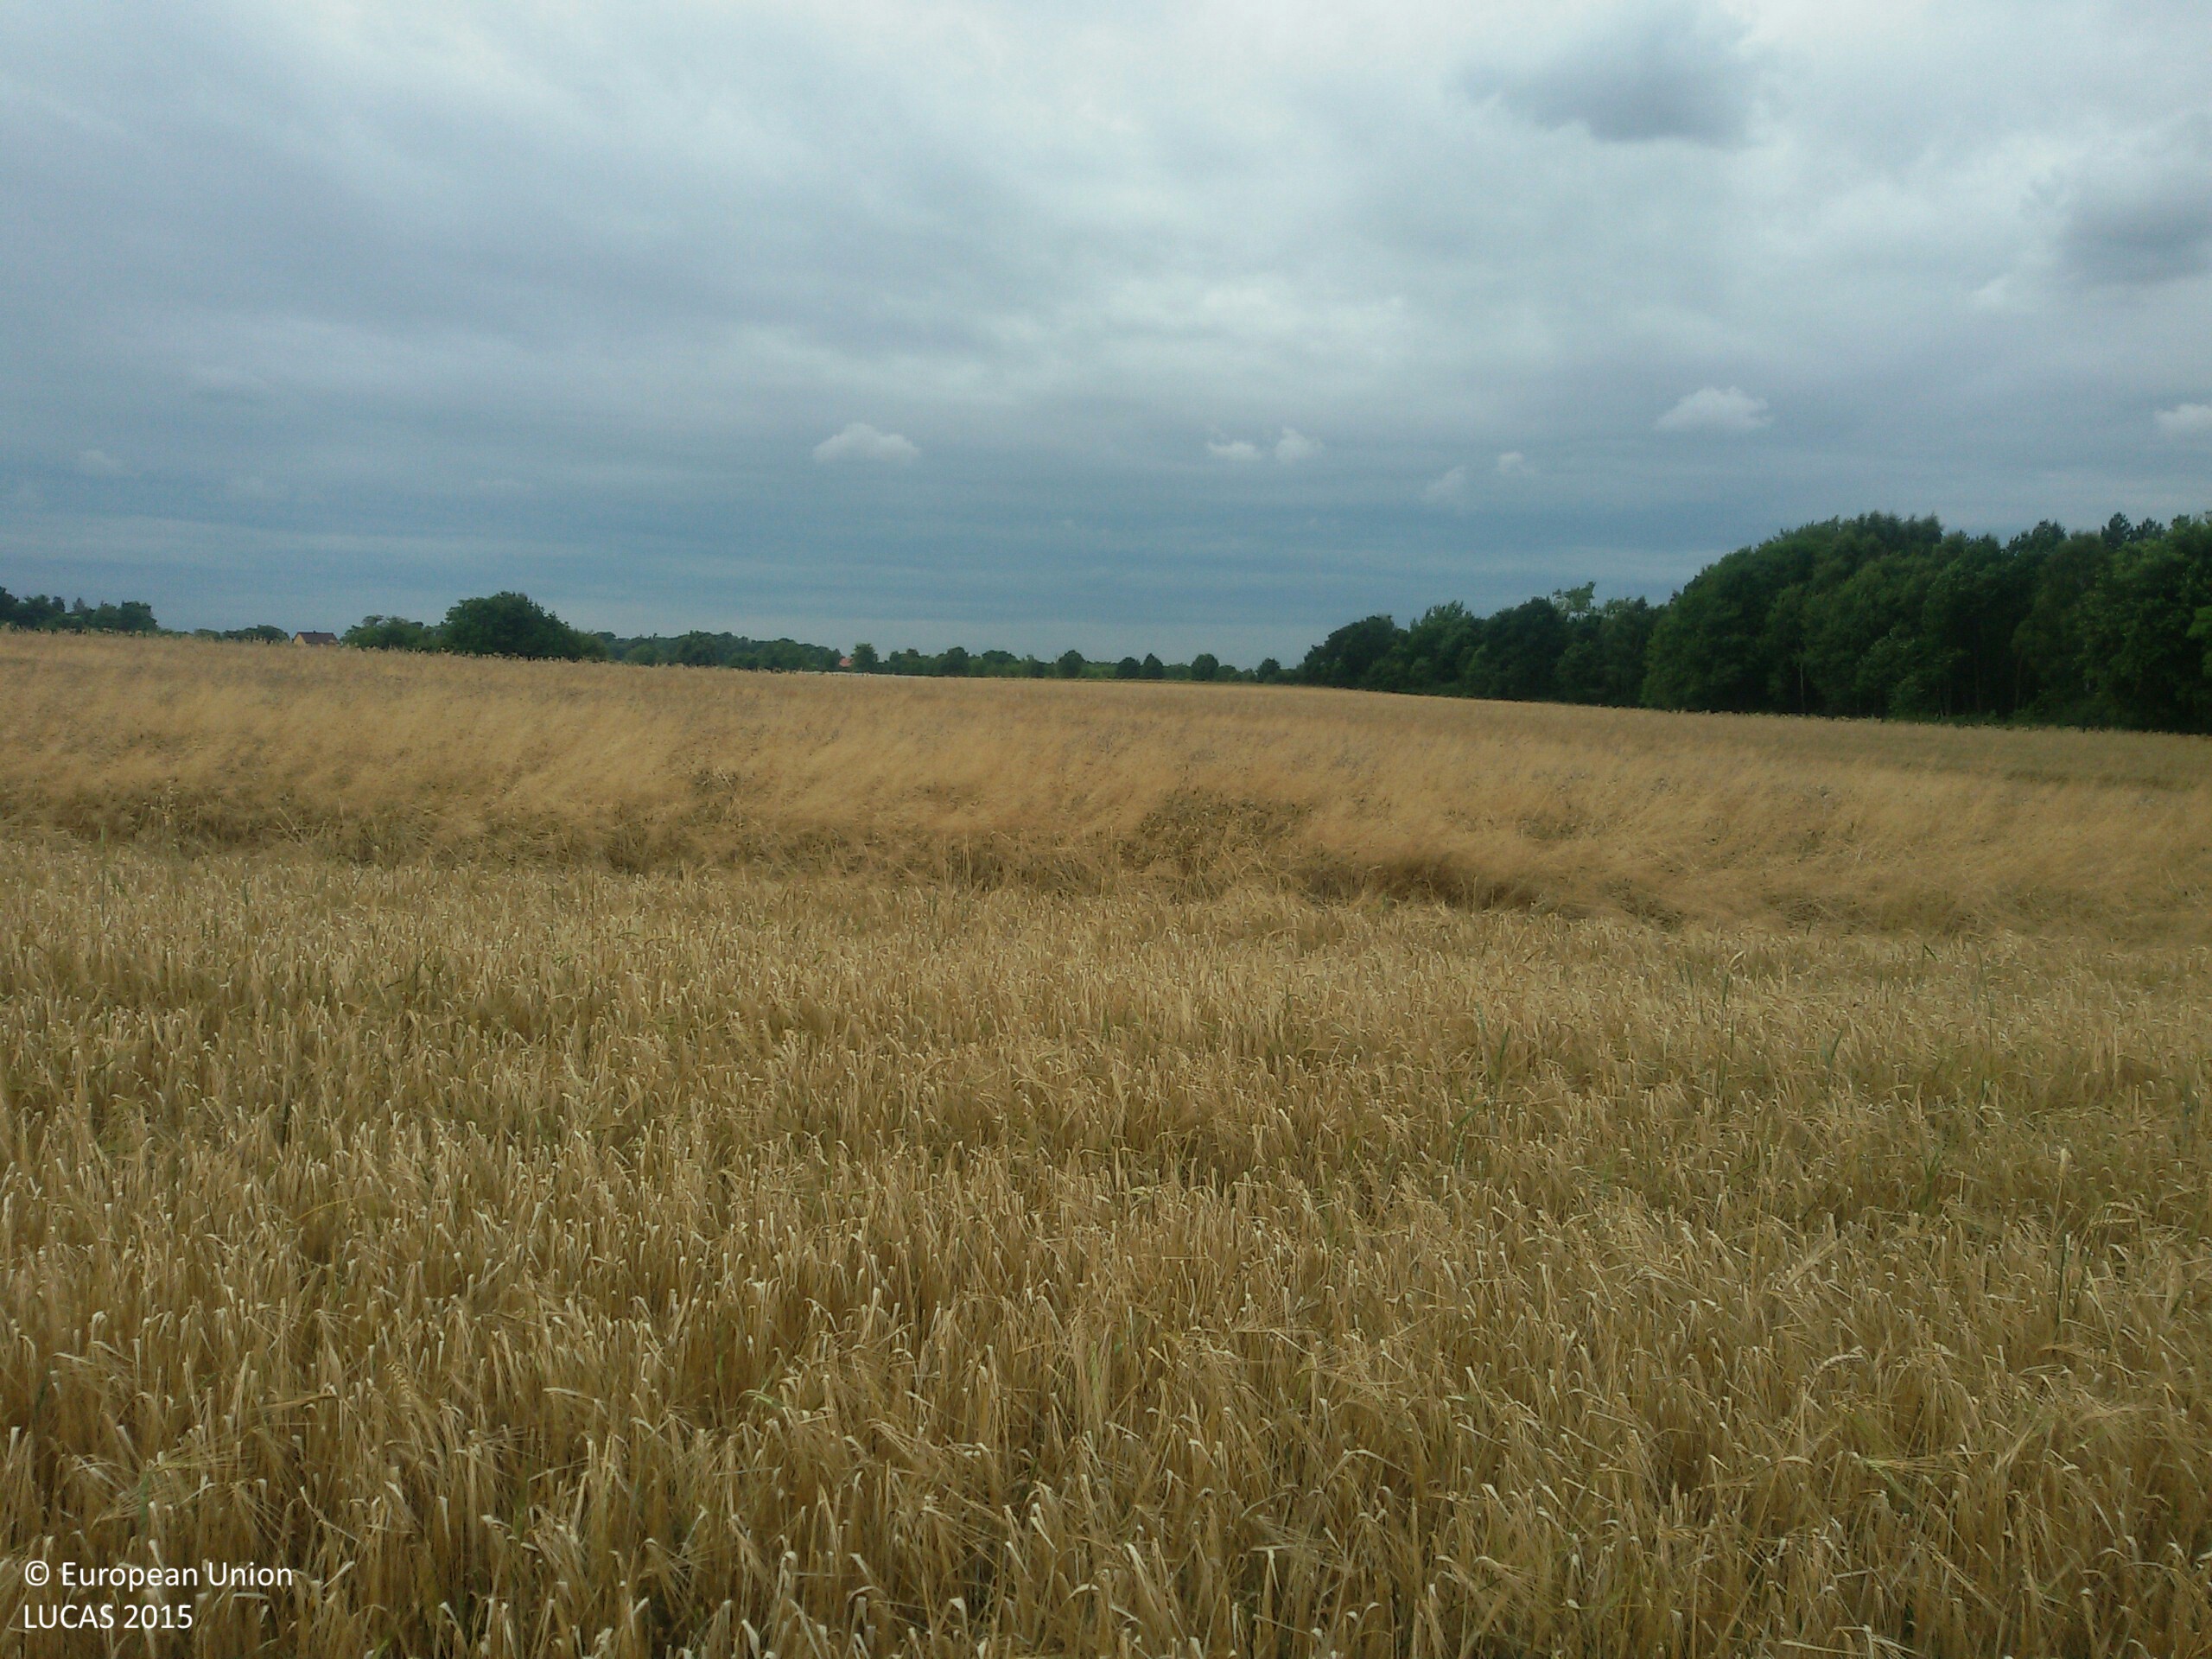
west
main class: Cropland
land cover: Barley
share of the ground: > 75 %
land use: Agriculture (excluding fallow land and kitchen gardens)
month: July
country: PL
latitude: 50.4670
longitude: 20.4203
